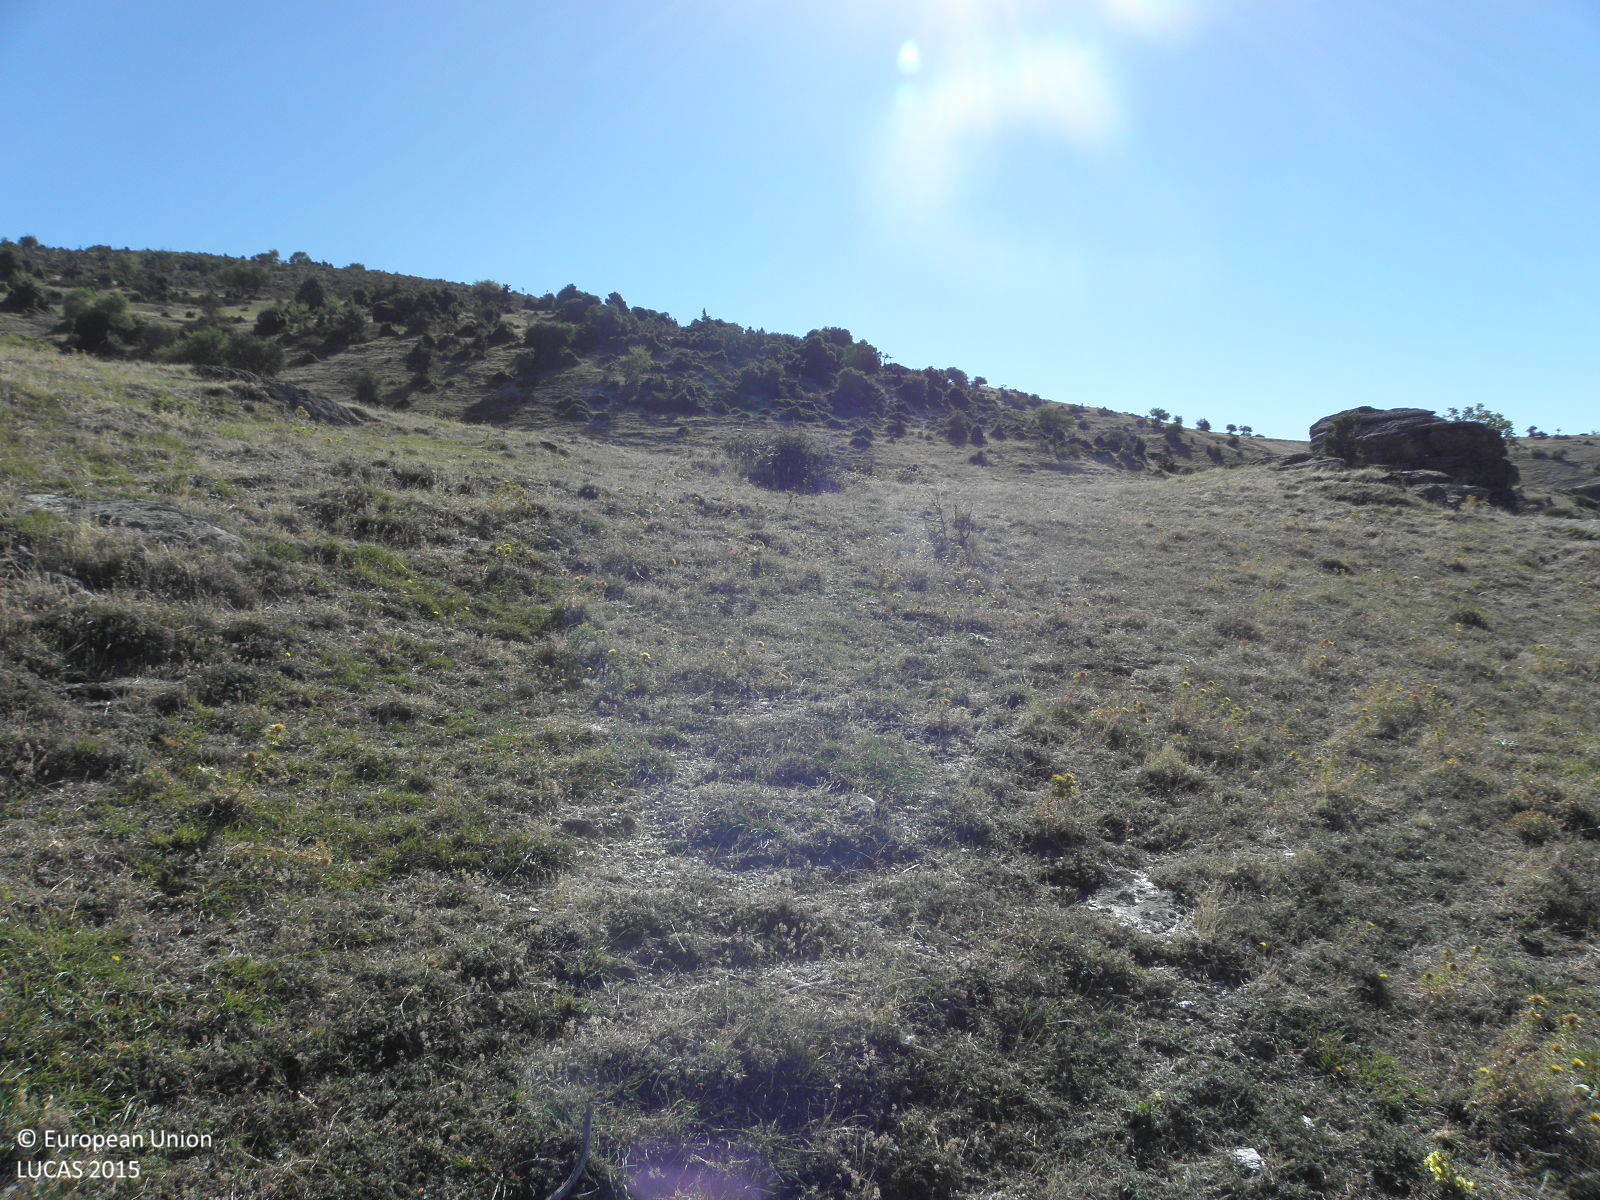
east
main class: Grassland
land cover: Grassland without tree/shrub cover
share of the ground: > 75 %
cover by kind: herbaceous plants 95 %, shrubs 5 %
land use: Agriculture (excluding fallow land and kitchen gardens)
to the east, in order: Grassland without tree/shrub cover; Shrubland without tree cover; Grassland with sparse tree/shrub cover
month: August
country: GR
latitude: 39.9274
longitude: 22.4551
